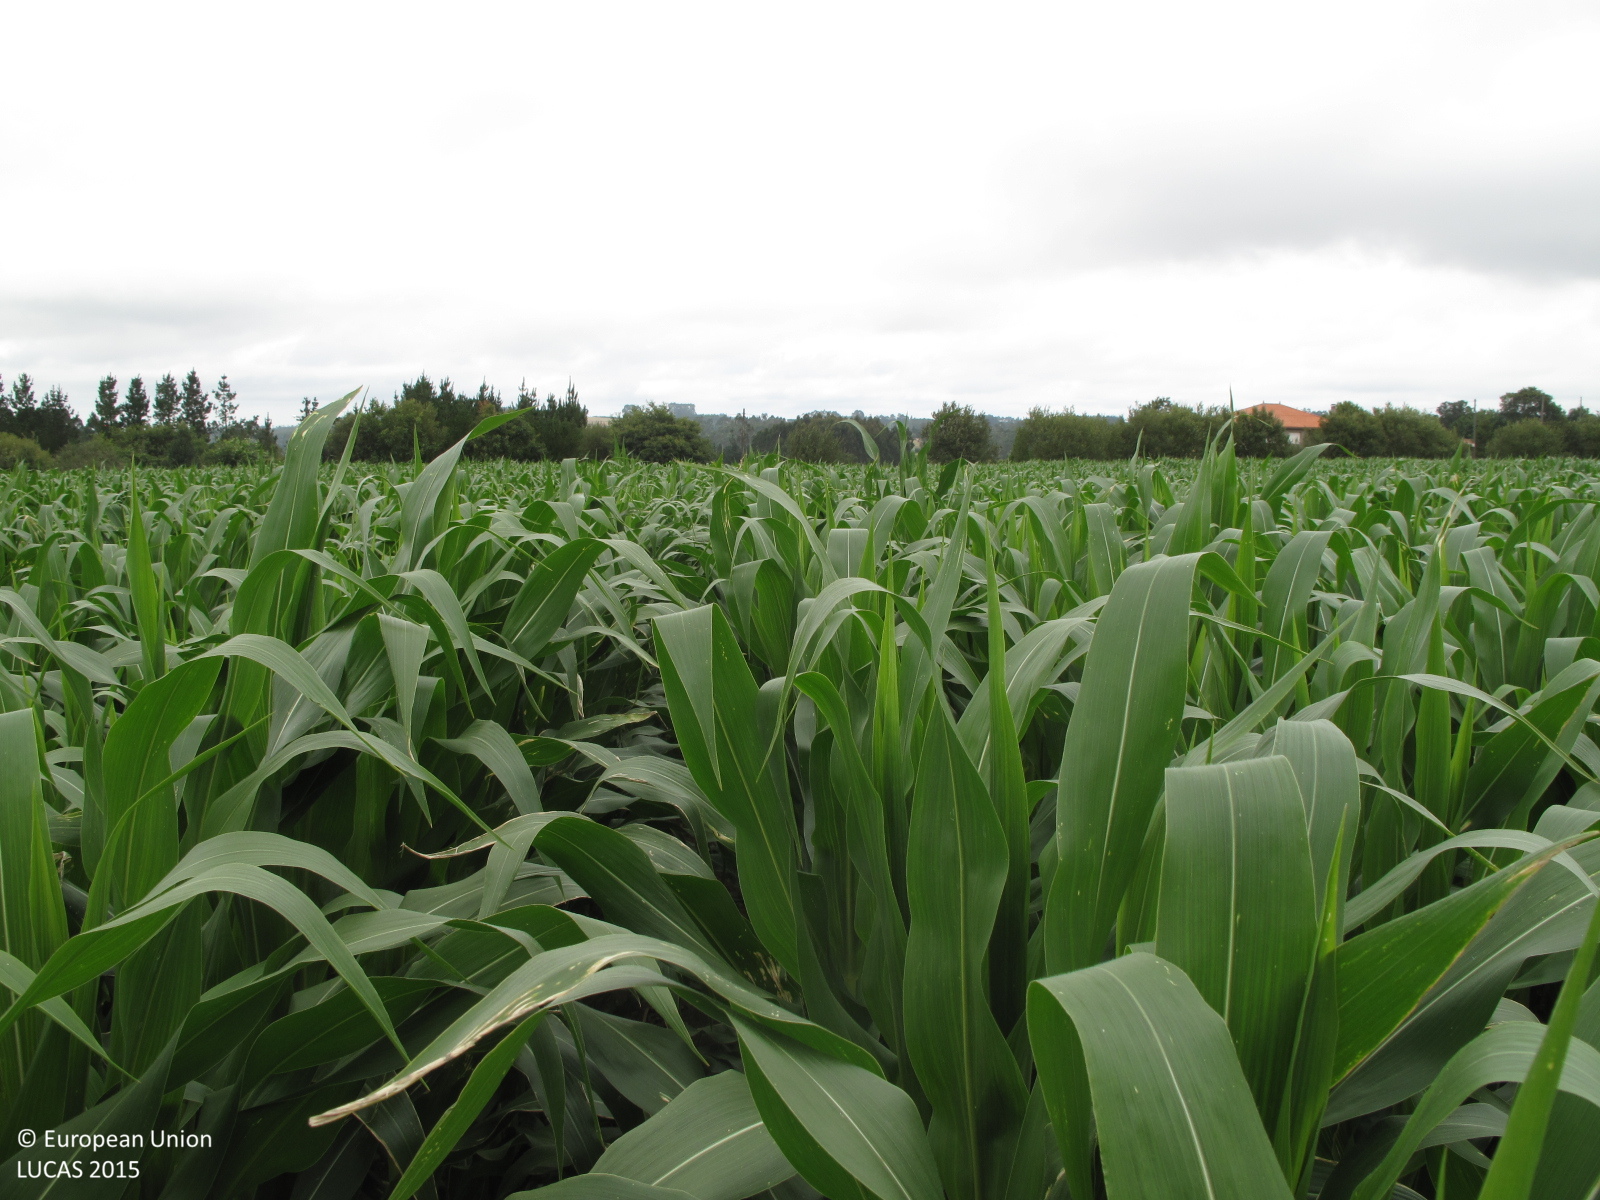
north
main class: Cropland
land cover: Maize
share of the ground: > 75 %
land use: Agriculture (excluding fallow land and kitchen gardens)
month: July
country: ES
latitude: 43.0989
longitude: -8.1695
